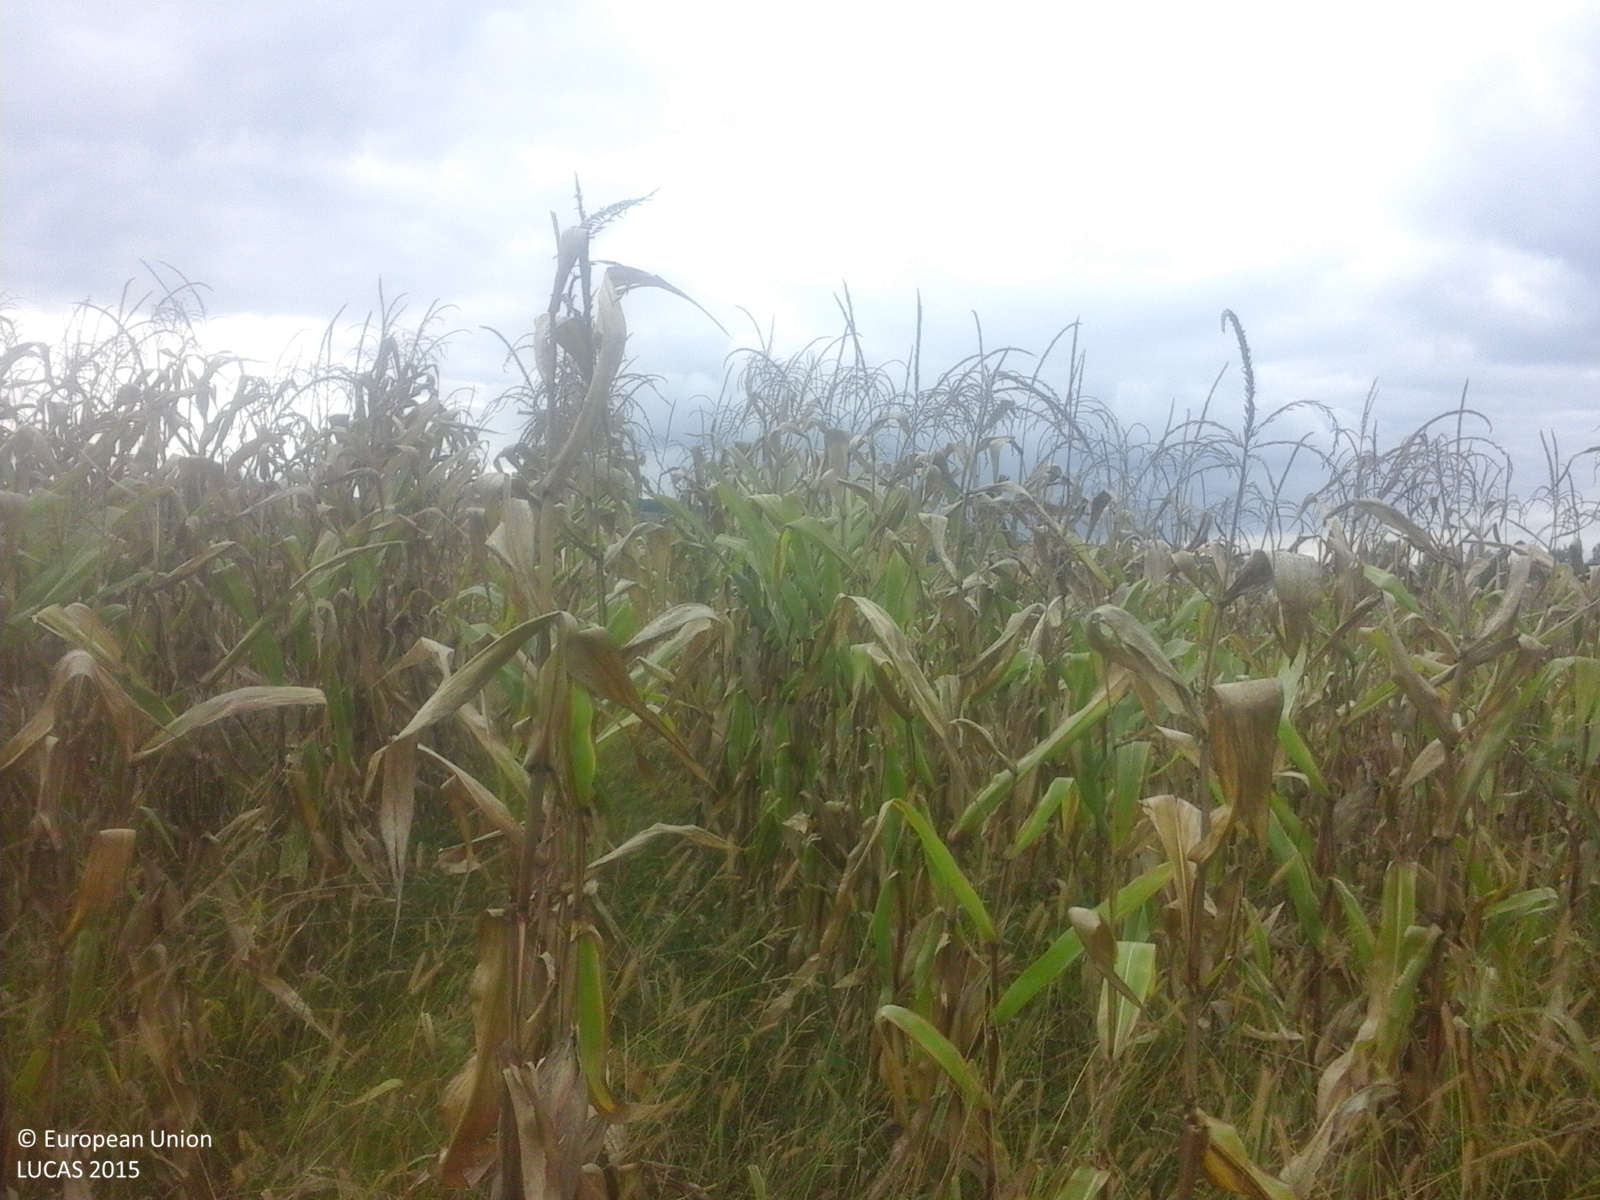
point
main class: Cropland
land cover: Maize
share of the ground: > 75 %
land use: Agriculture (excluding fallow land and kitchen gardens)
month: September
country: RO
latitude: 45.8597
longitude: 23.8906
